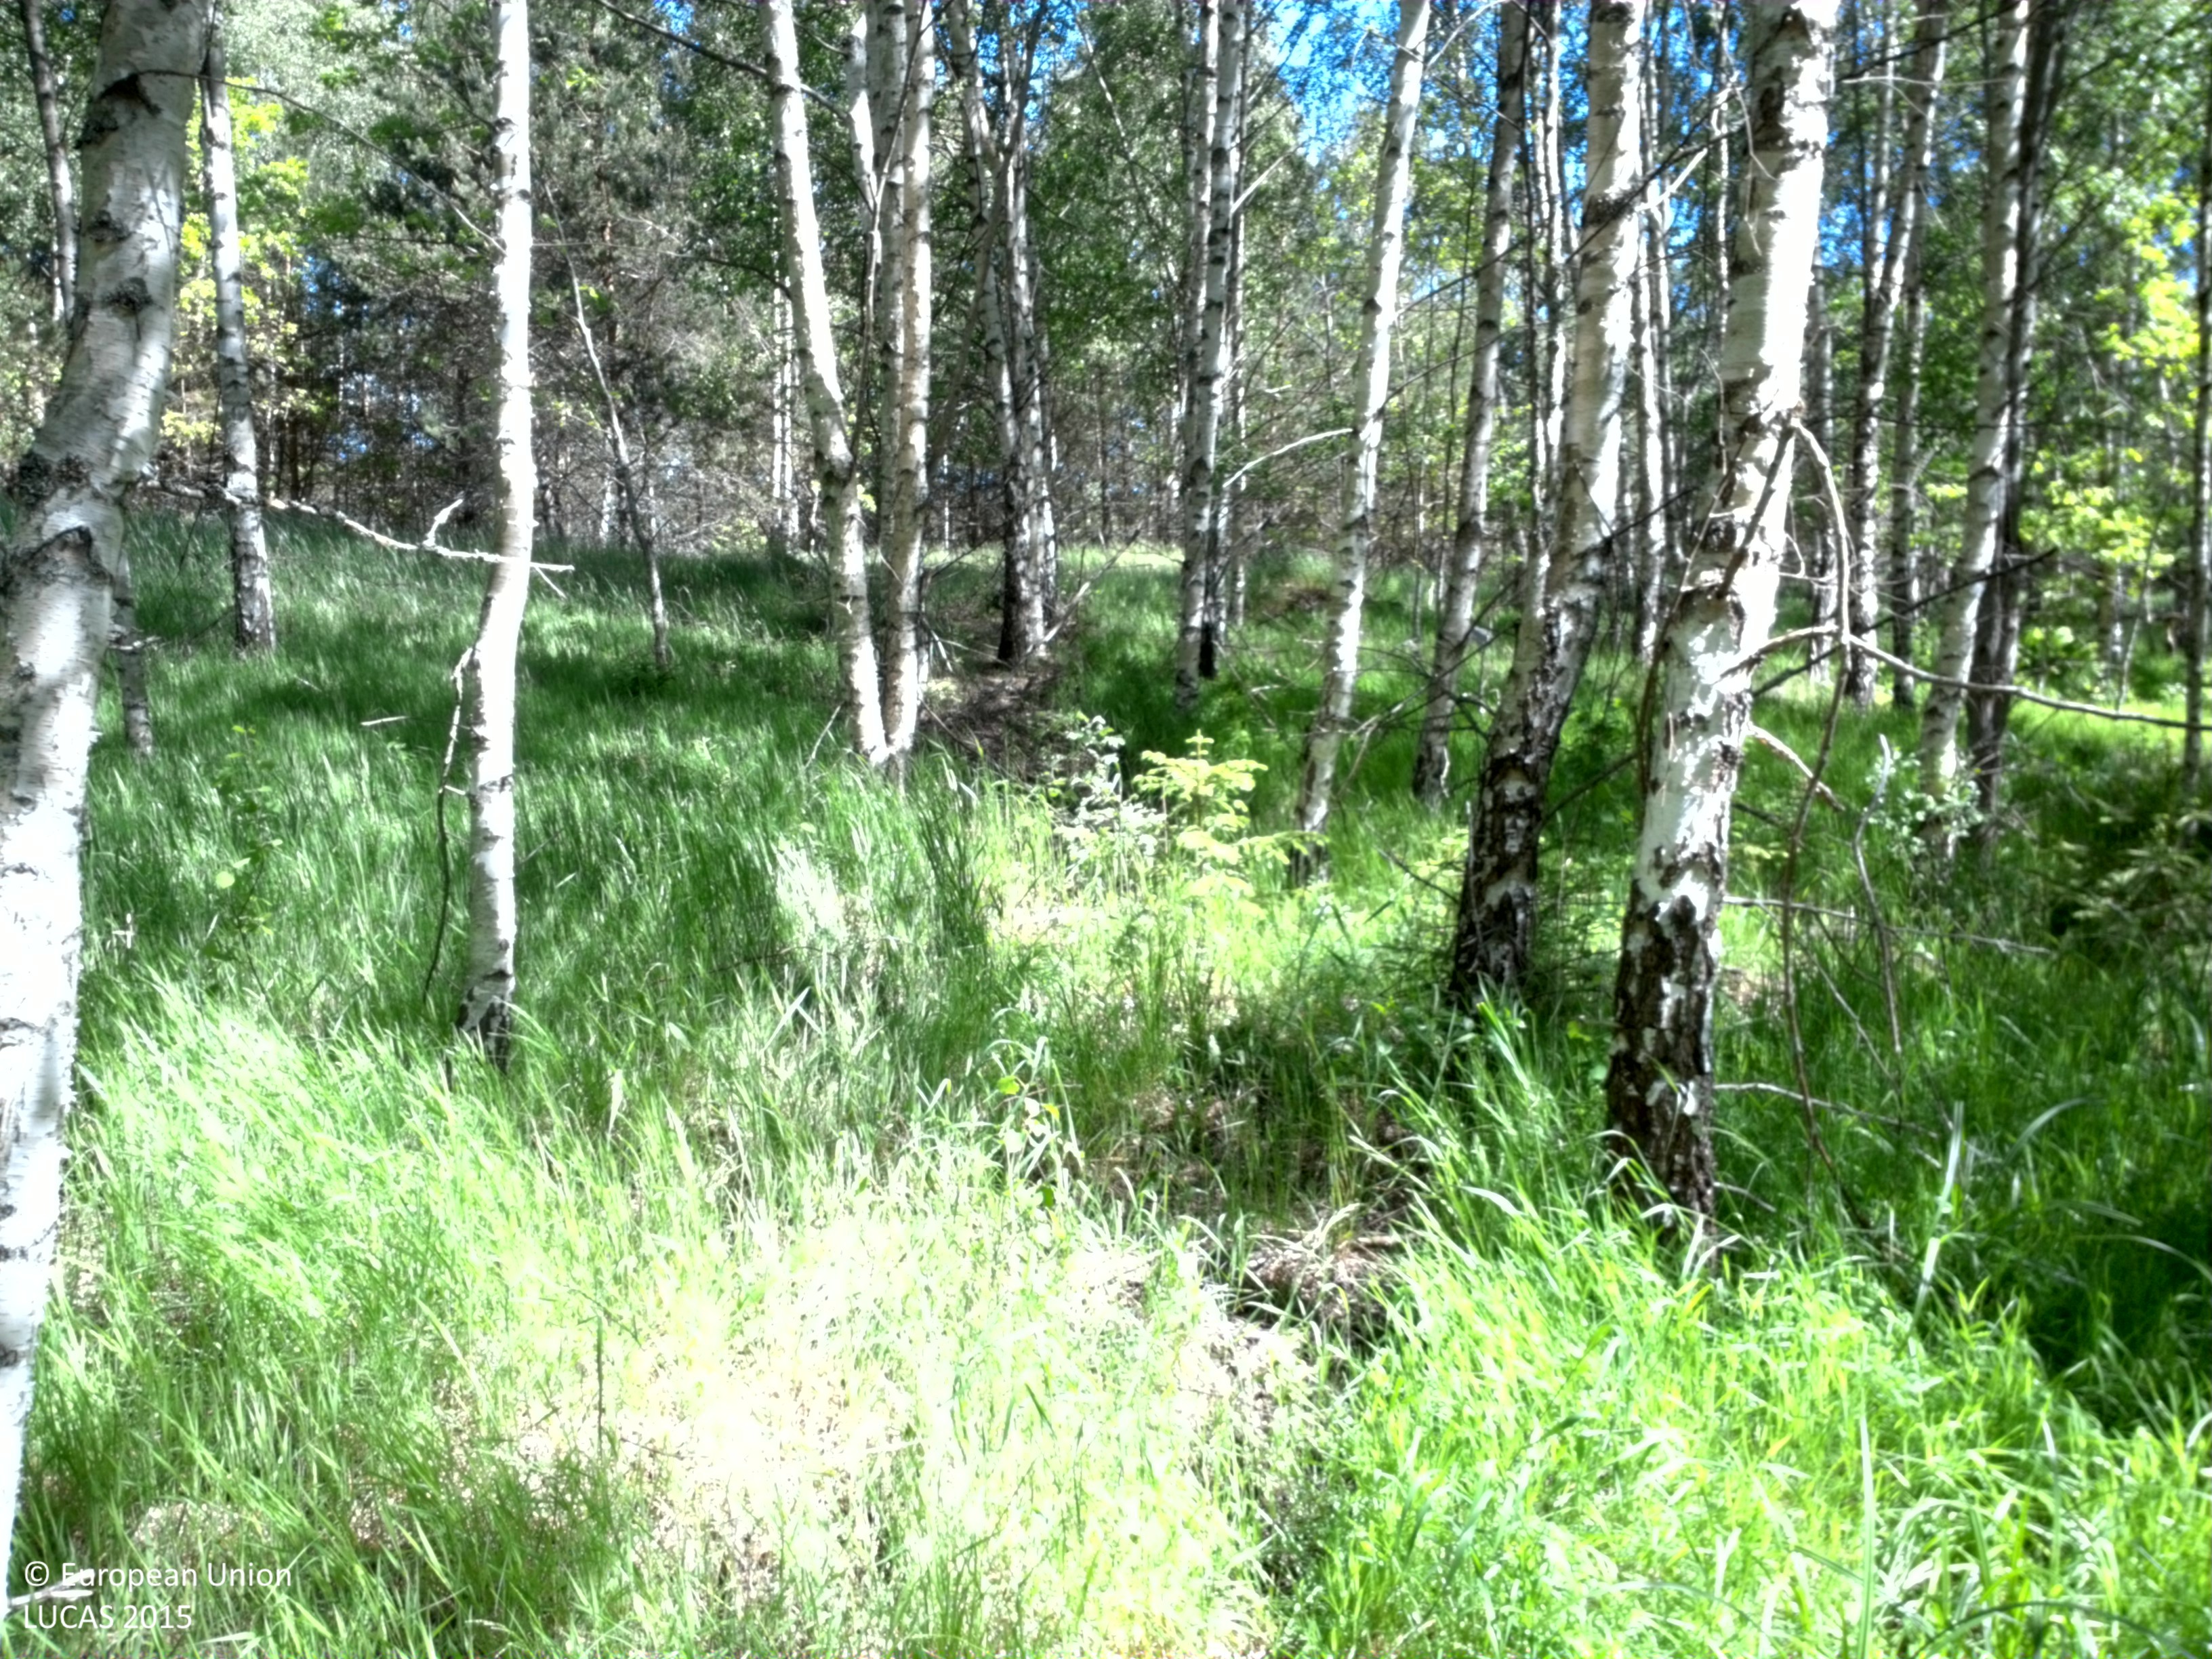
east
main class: Woodland
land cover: Broadleaved woodland
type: acidophilous oak and oak-birch forest
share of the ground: 25 - 50 %
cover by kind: herbaceous plants 50 %, broadleaved forest trees 35 %, lichens and mosses 10 %, coniferous forest trees 5 %
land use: Forestry
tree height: > 5 m
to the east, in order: Broadleaved woodland; Grassland without tree/shrub cover; Pine dominated mixed woodland; Grass margins; Paved roads, cycling and walking lanes; Grass margins; Grassland without tree/shrub cover; Paved roads, cycling and walking lanes; Spontaneously vegetated surfaces; Artificial constructions in urban areas; Broadleaved woodland; Rivers and streams; Broadleaved woodland
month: June
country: SE
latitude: 58.6875
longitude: 16.2571
